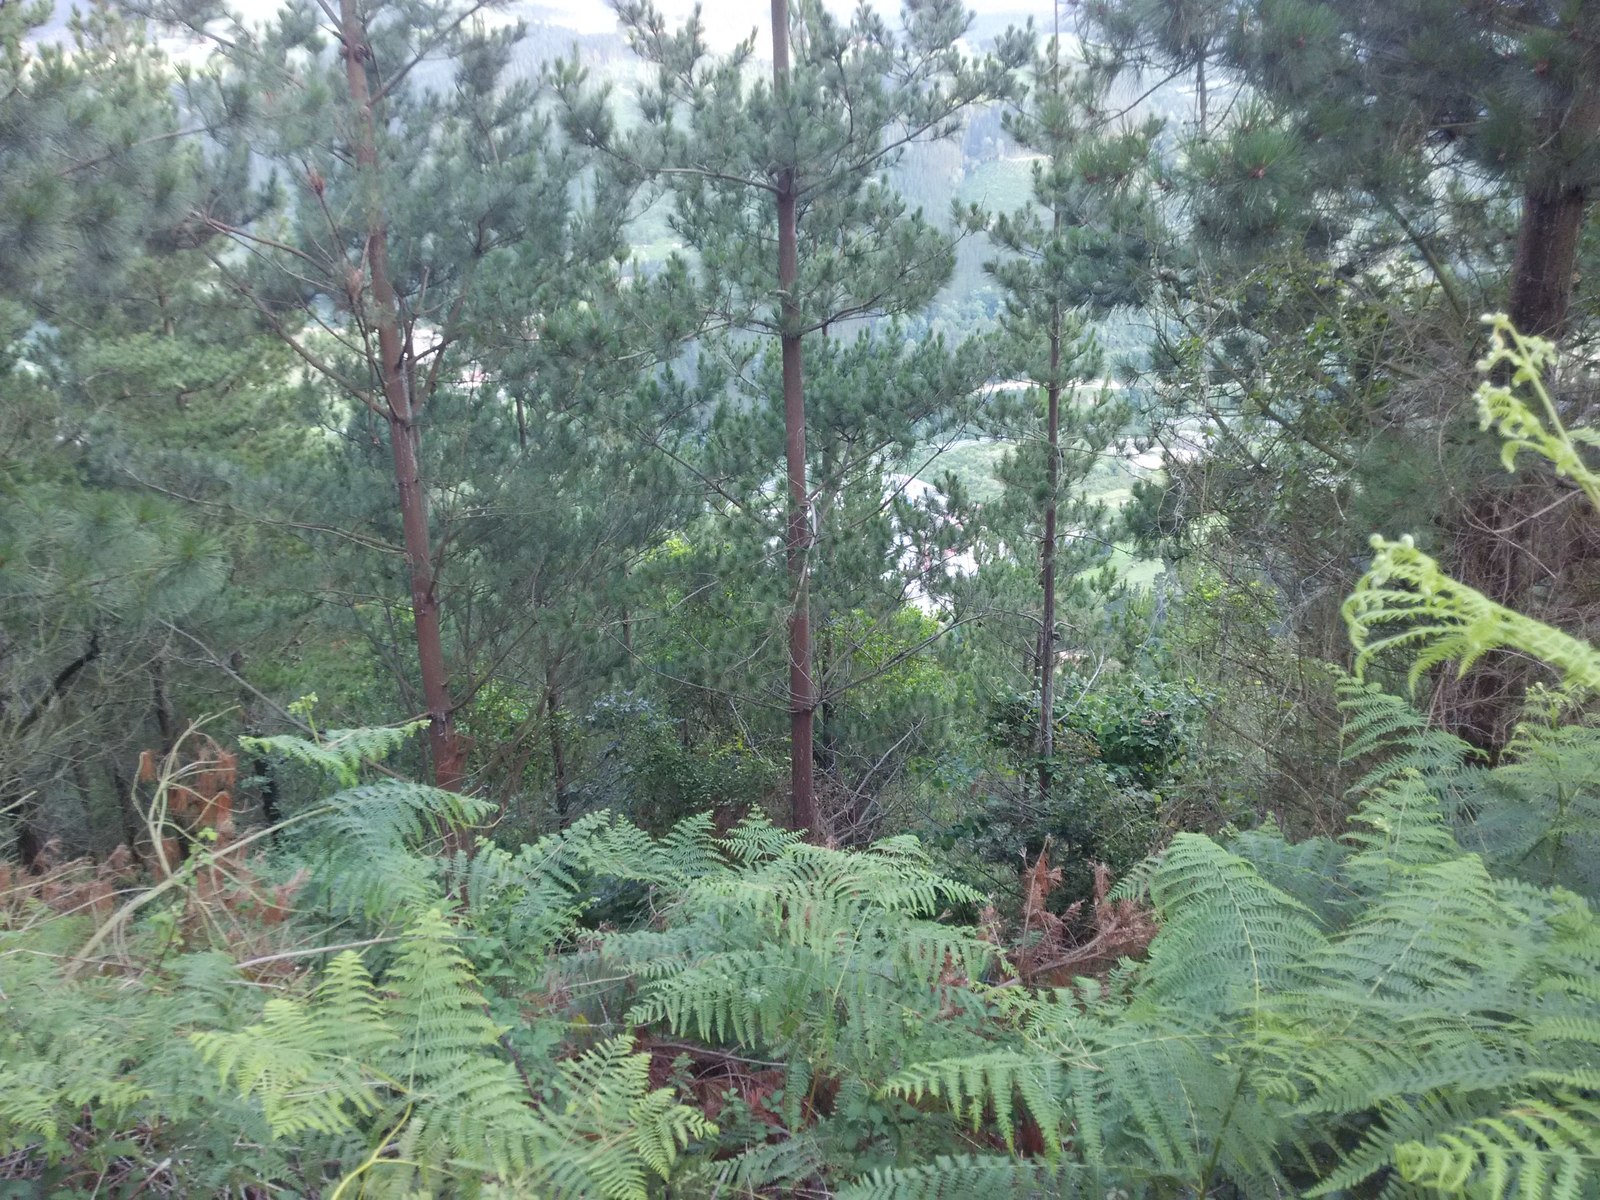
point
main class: Woodland
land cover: Pine dominated coniferous woodland
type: exotic forest
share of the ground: > 75 %
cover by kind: coniferous forest trees 80 %, shrubs 20 %
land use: Forestry
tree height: > 5 m
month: June
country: ES
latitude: 43.3245
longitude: -2.4463
